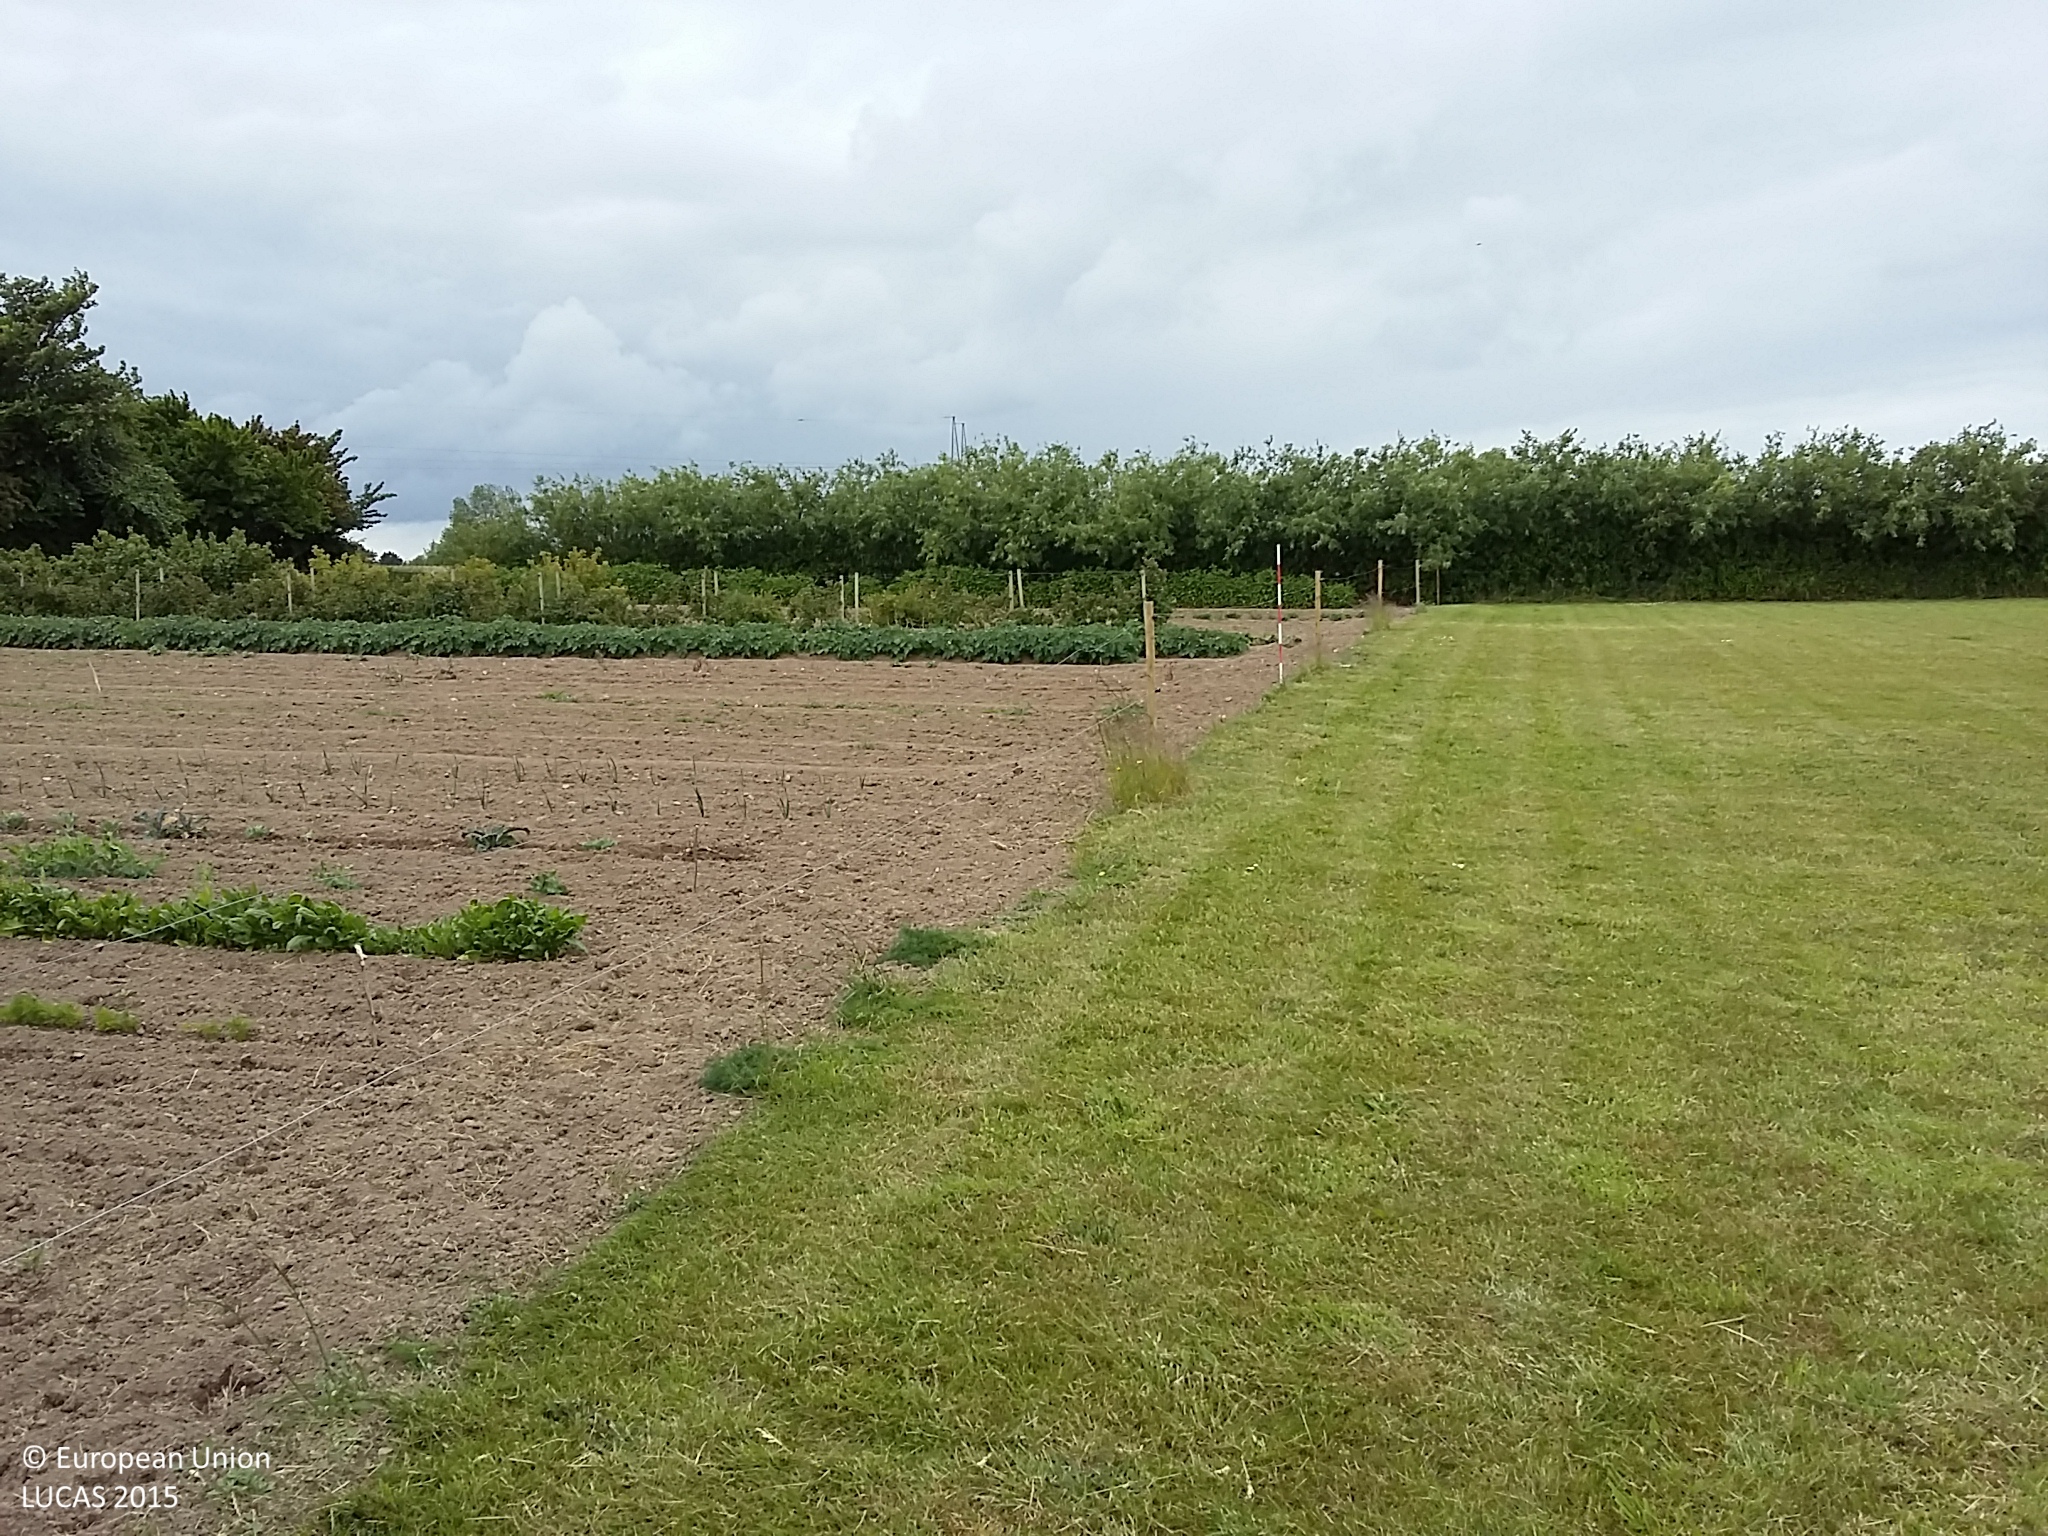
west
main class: Grassland
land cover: Grassland without tree/shrub cover
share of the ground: > 75 %
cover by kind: herbaceous plants 100 %
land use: Residential
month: June
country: DK
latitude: 54.8915
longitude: 10.7322
